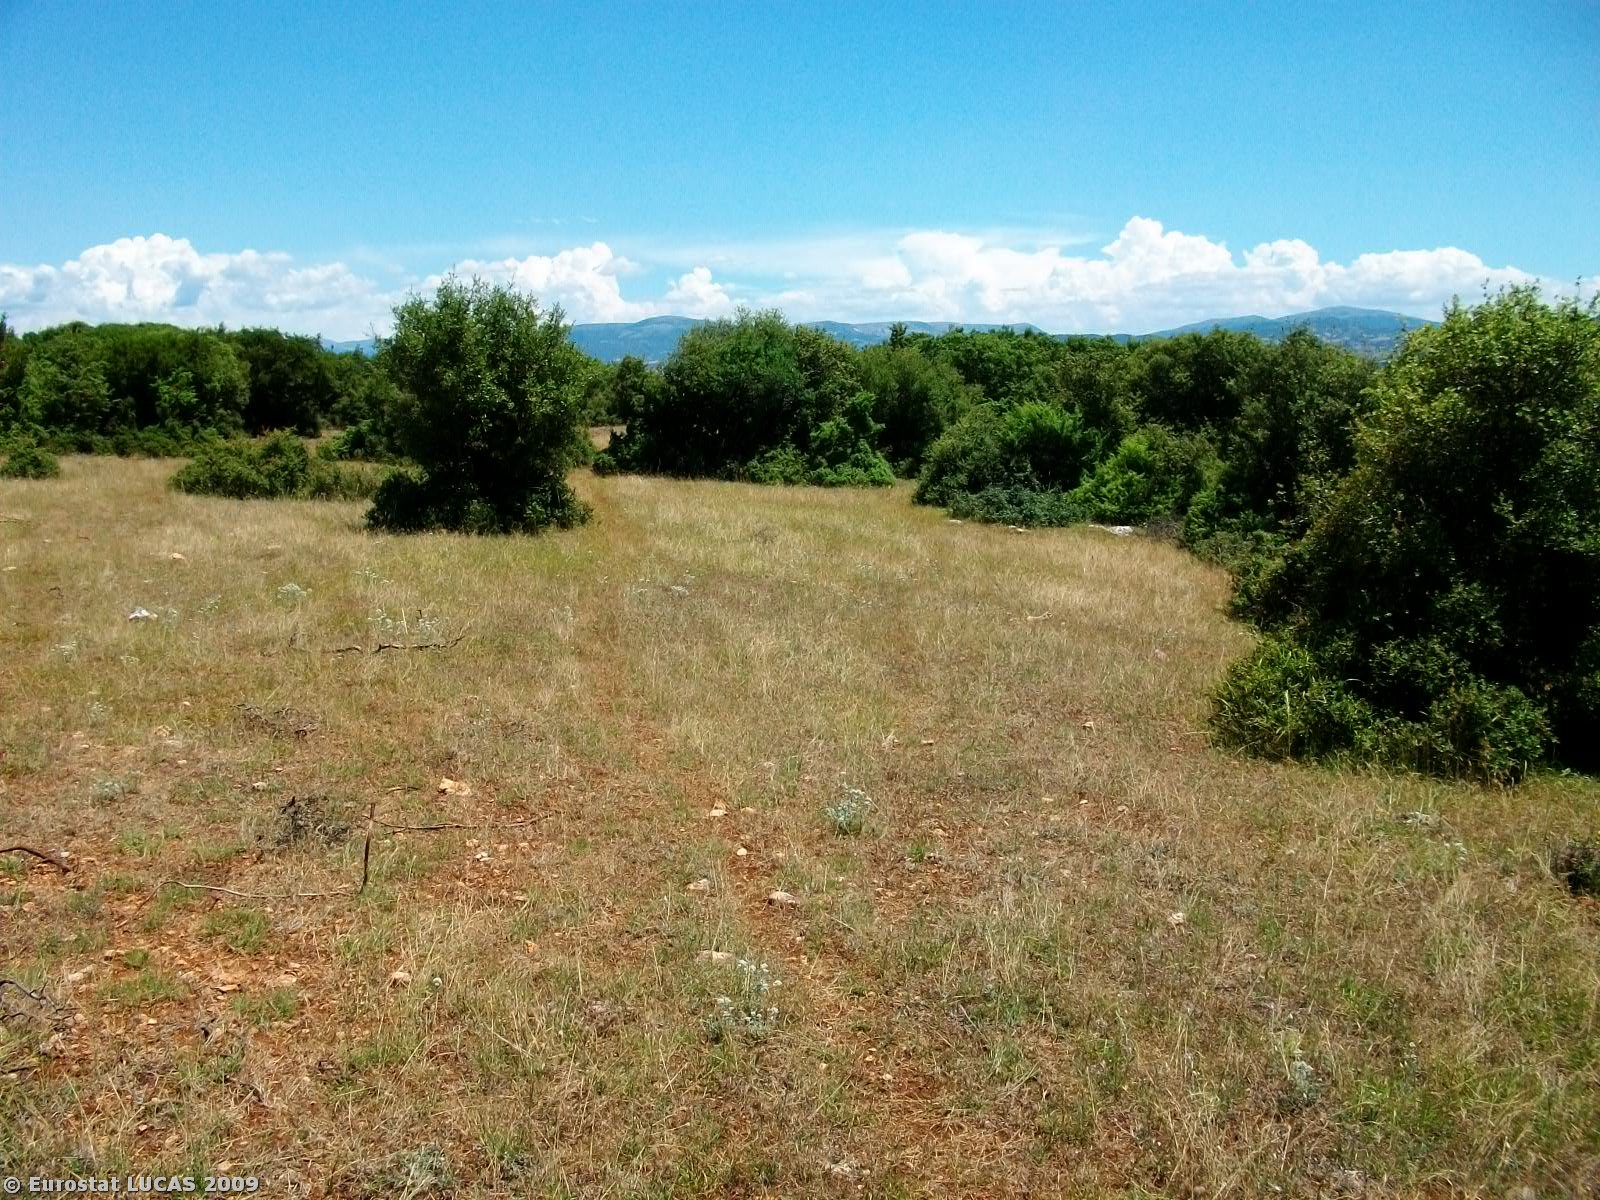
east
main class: Shrubland
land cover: Shrubland without tree cover
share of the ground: 50 - 75 %
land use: Unused
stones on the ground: 10 - 25 %
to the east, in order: Shrubland without tree cover
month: July
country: GR
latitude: 40.1209
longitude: 21.7825
